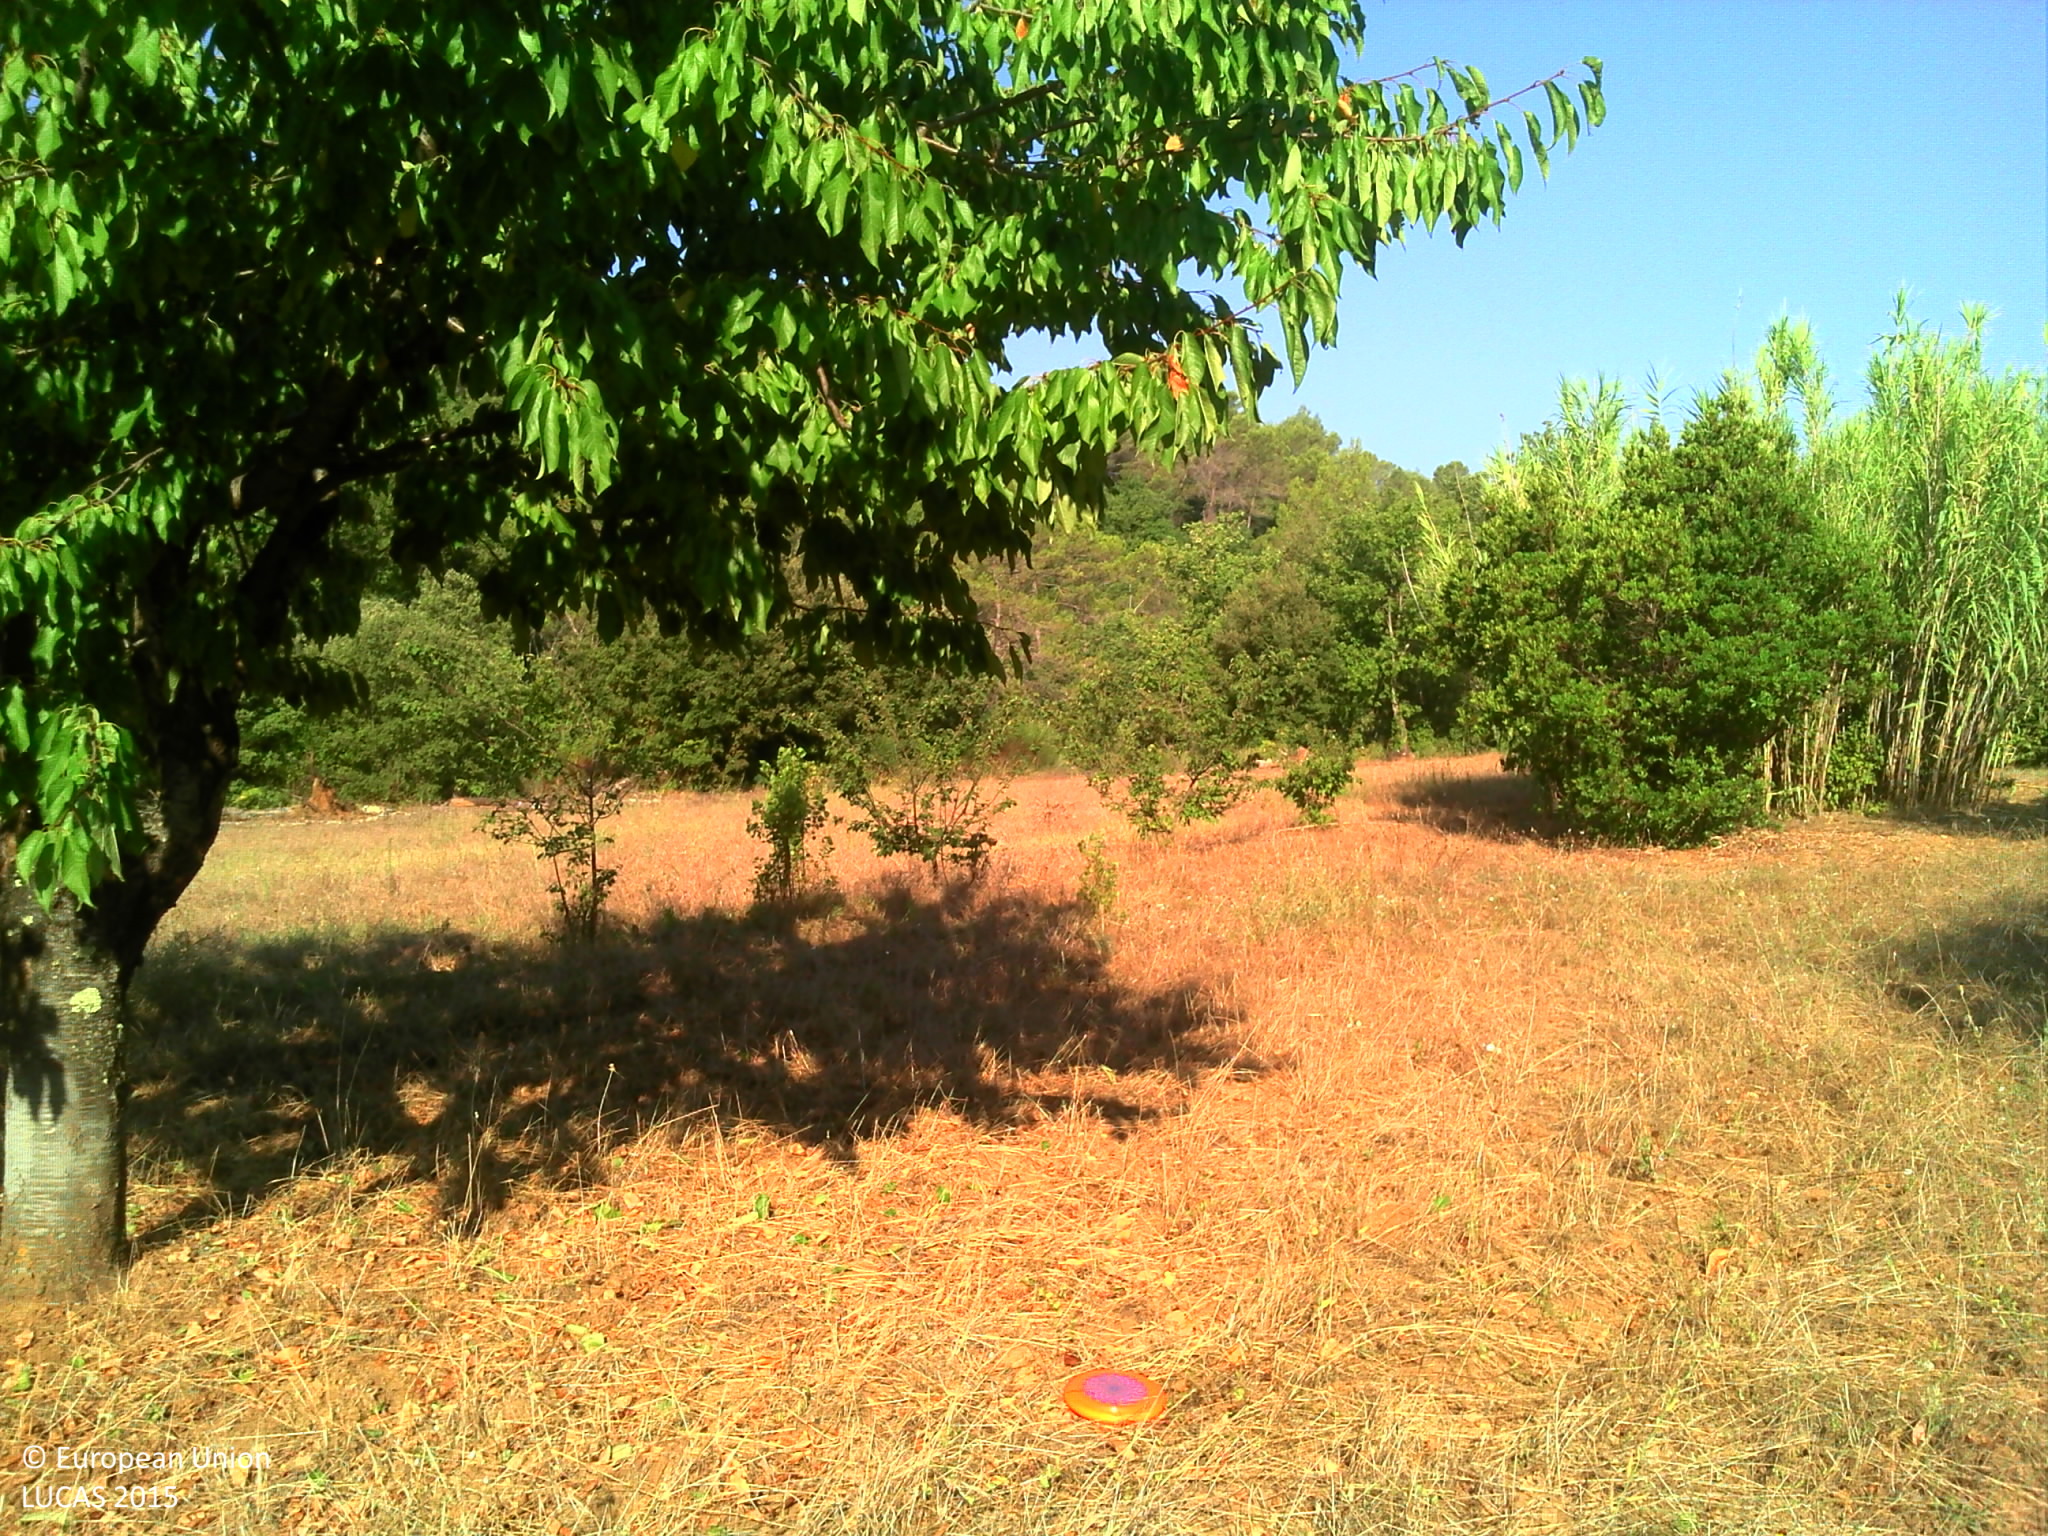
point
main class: Grassland
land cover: Grassland with sparse tree/shrub cover
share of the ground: > 75 %
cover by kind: herbaceous plants 95 %, broadleaved forest trees 5 %
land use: Residential
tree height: > 5 m
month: August
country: FR
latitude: 43.5111
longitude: 6.3843
